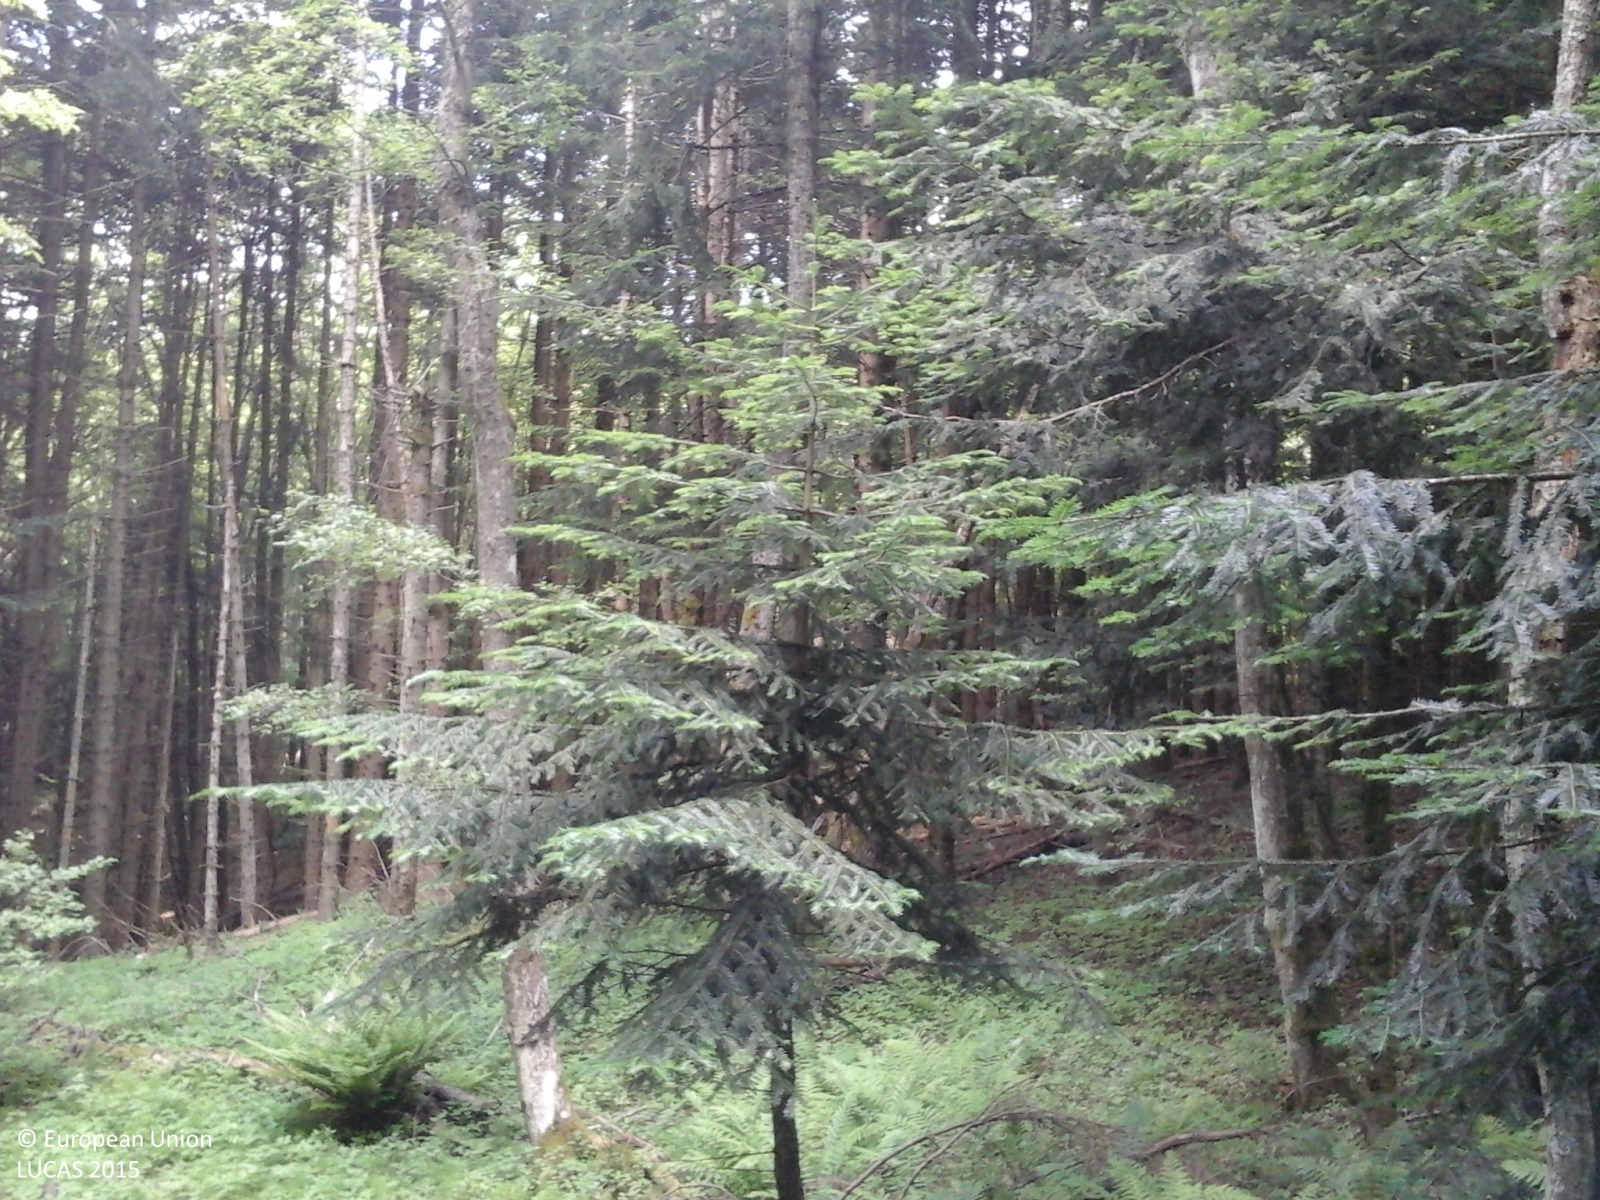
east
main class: Woodland
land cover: Spruce dominated mixed woodland
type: alpine coniferous forest
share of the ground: > 75 %
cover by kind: coniferous forest trees 75 %, broadleaved forest trees 25 %
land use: Forestry
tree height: > 5 m
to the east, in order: Spruce dominated mixed woodland; Other mixed woodland; Rivers and streams; Broadleaved woodland
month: June
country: IT
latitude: 44.2943
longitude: 10.6627
